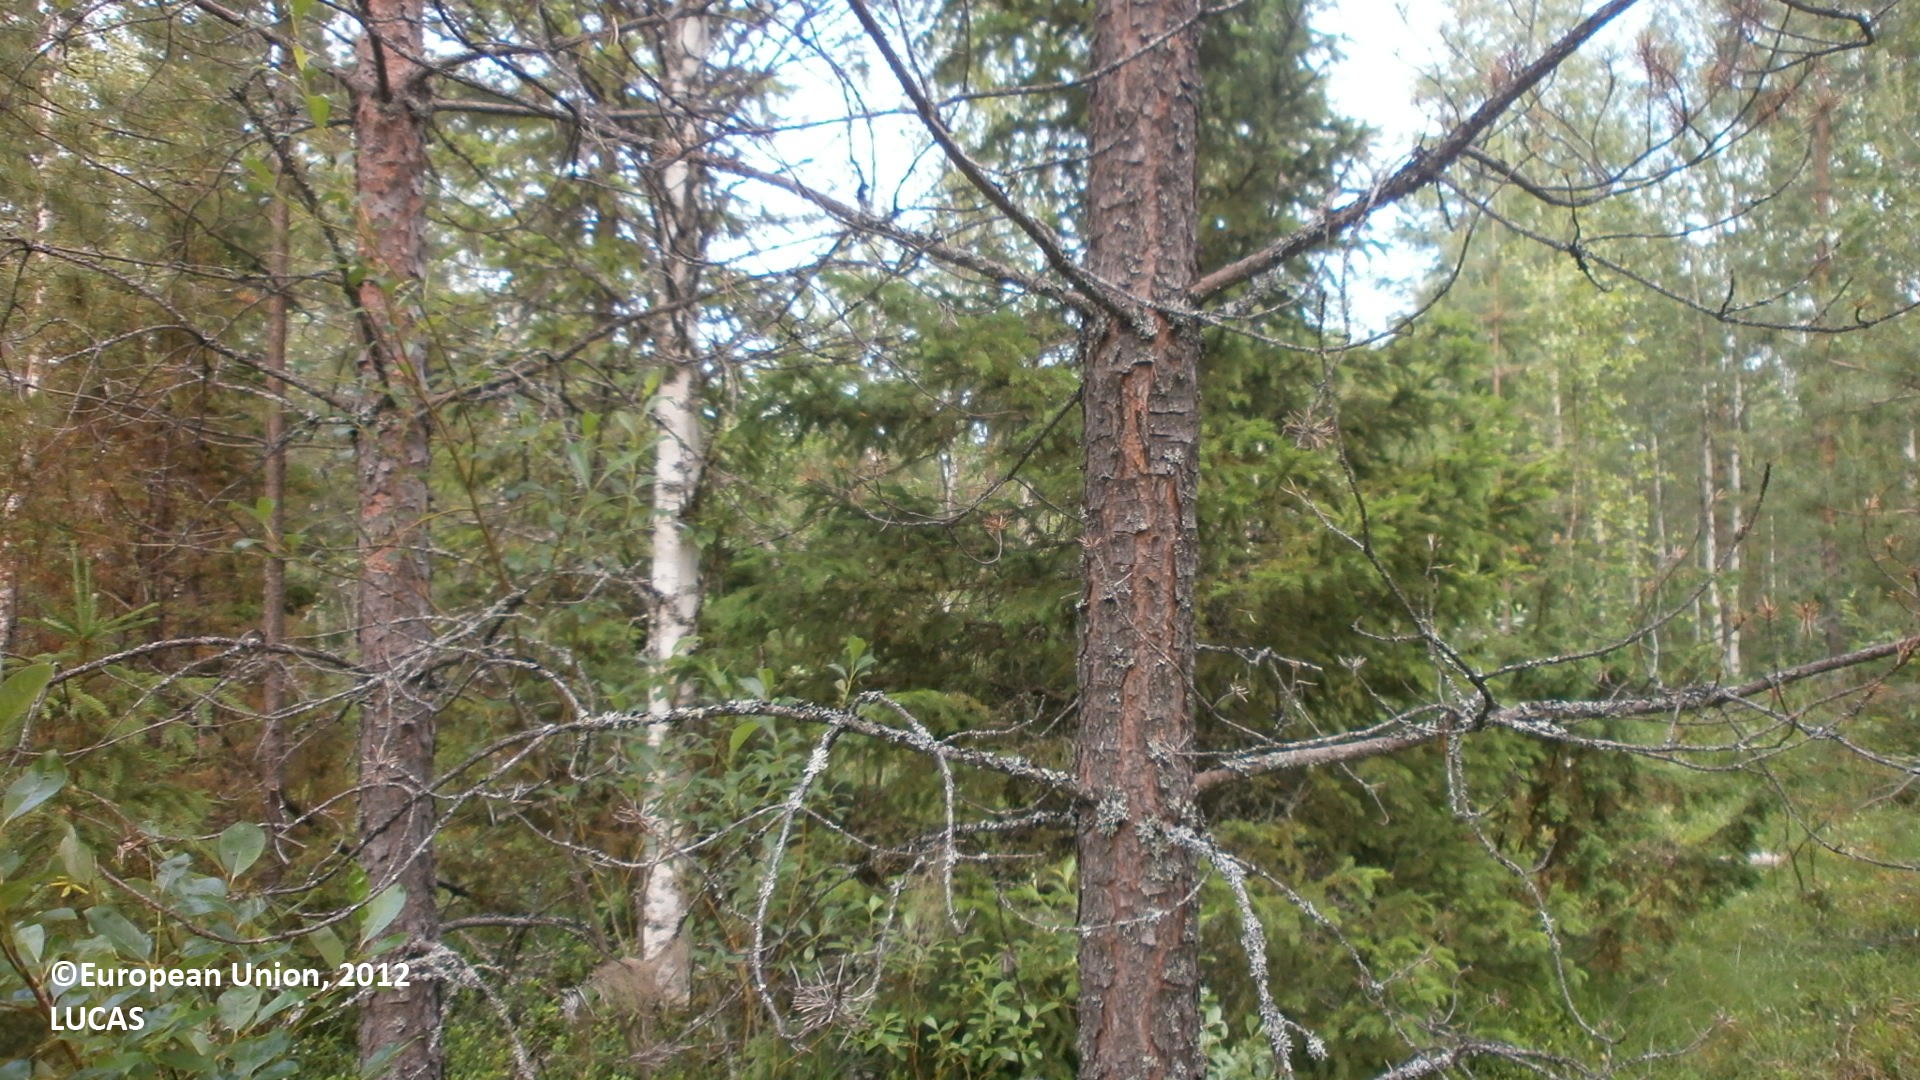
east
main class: Woodland
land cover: Pine dominated mixed woodland
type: boreal forest
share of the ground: 50 - 75 %
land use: Forestry
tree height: > 5 m
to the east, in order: Pine dominated mixed woodland; Grassland with sparse tree/shrub cover; Pine dominated mixed woodland; Ditches and canals; Pine dominated mixed woodland; Tracks; Pine dominated mixed woodland; Ditches and canals; Broadleaved woodland; Tracks; Broadleaved woodland; Tracks; Pine dominated mixed woodland; Ditches and canals; Pine dominated mixed woodland
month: July
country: FI
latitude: 64.2281
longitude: 24.8595
